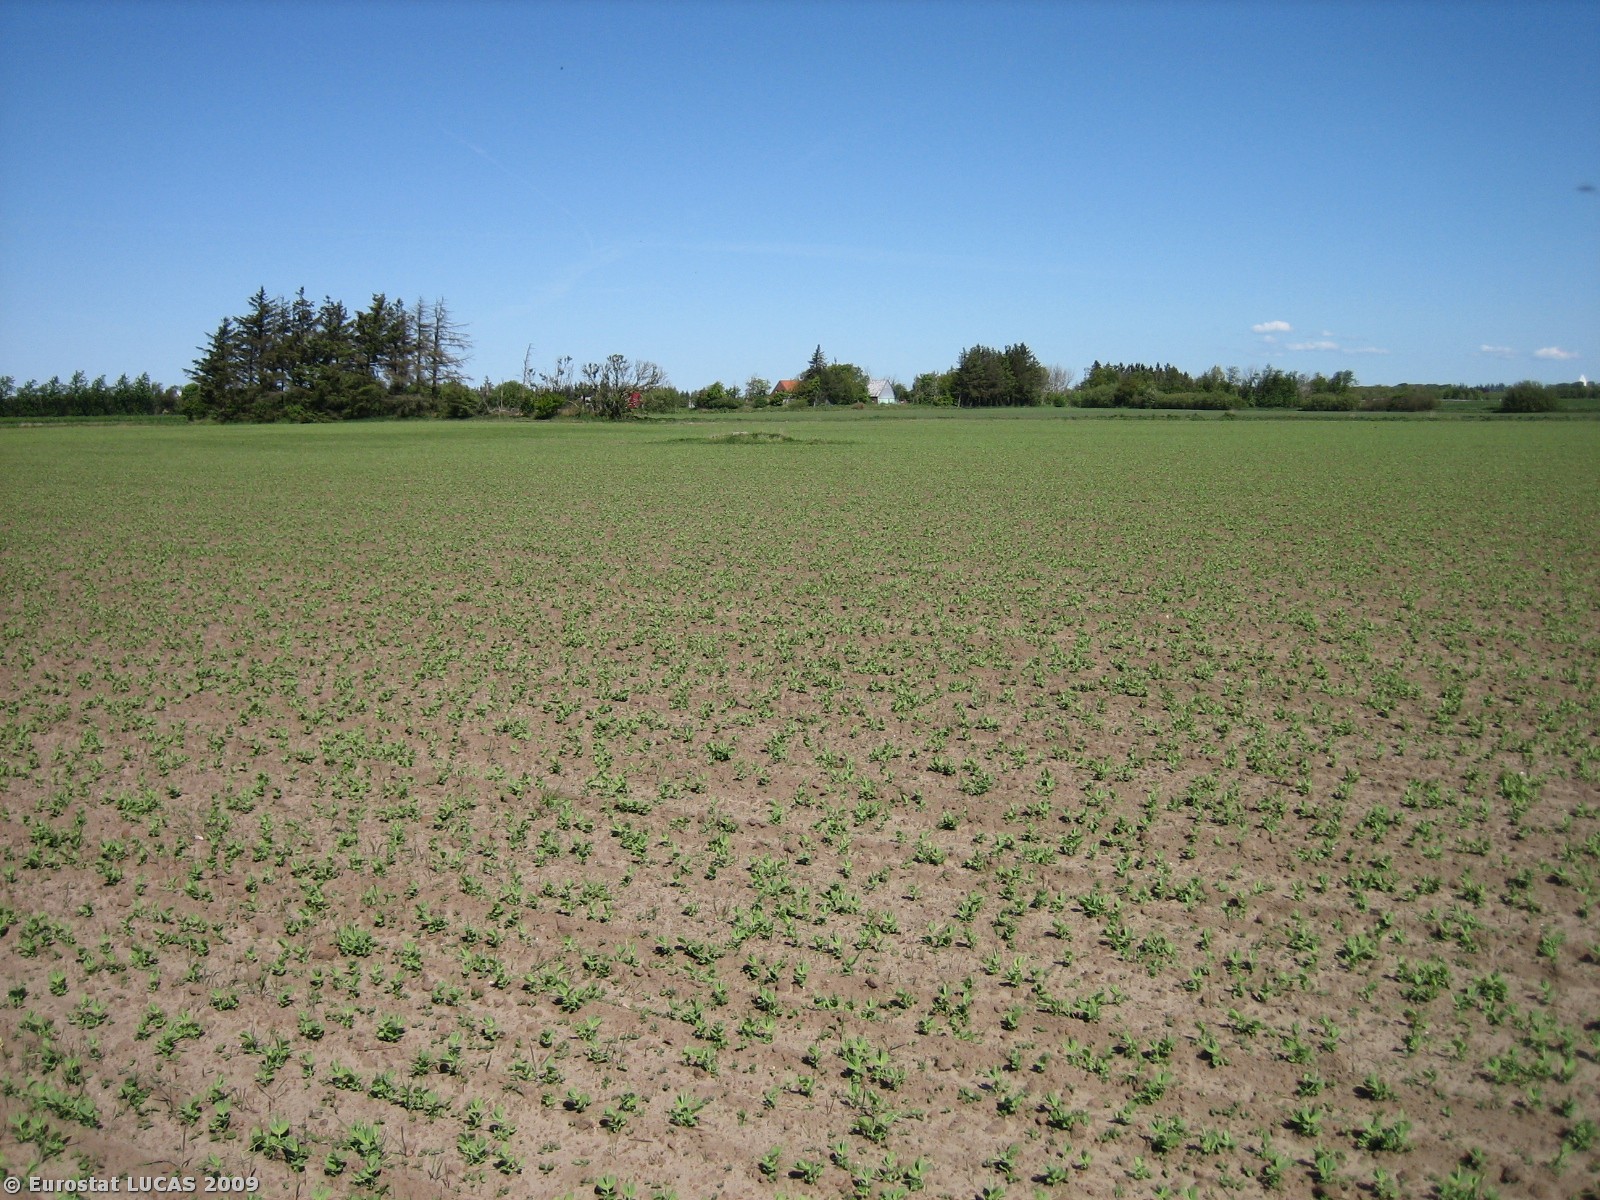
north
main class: Cropland
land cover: Dry pulses
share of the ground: 25 - 50 %
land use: Agriculture (excluding fallow land and kitchen gardens)
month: May
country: DK
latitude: 56.2849
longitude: 8.3380
